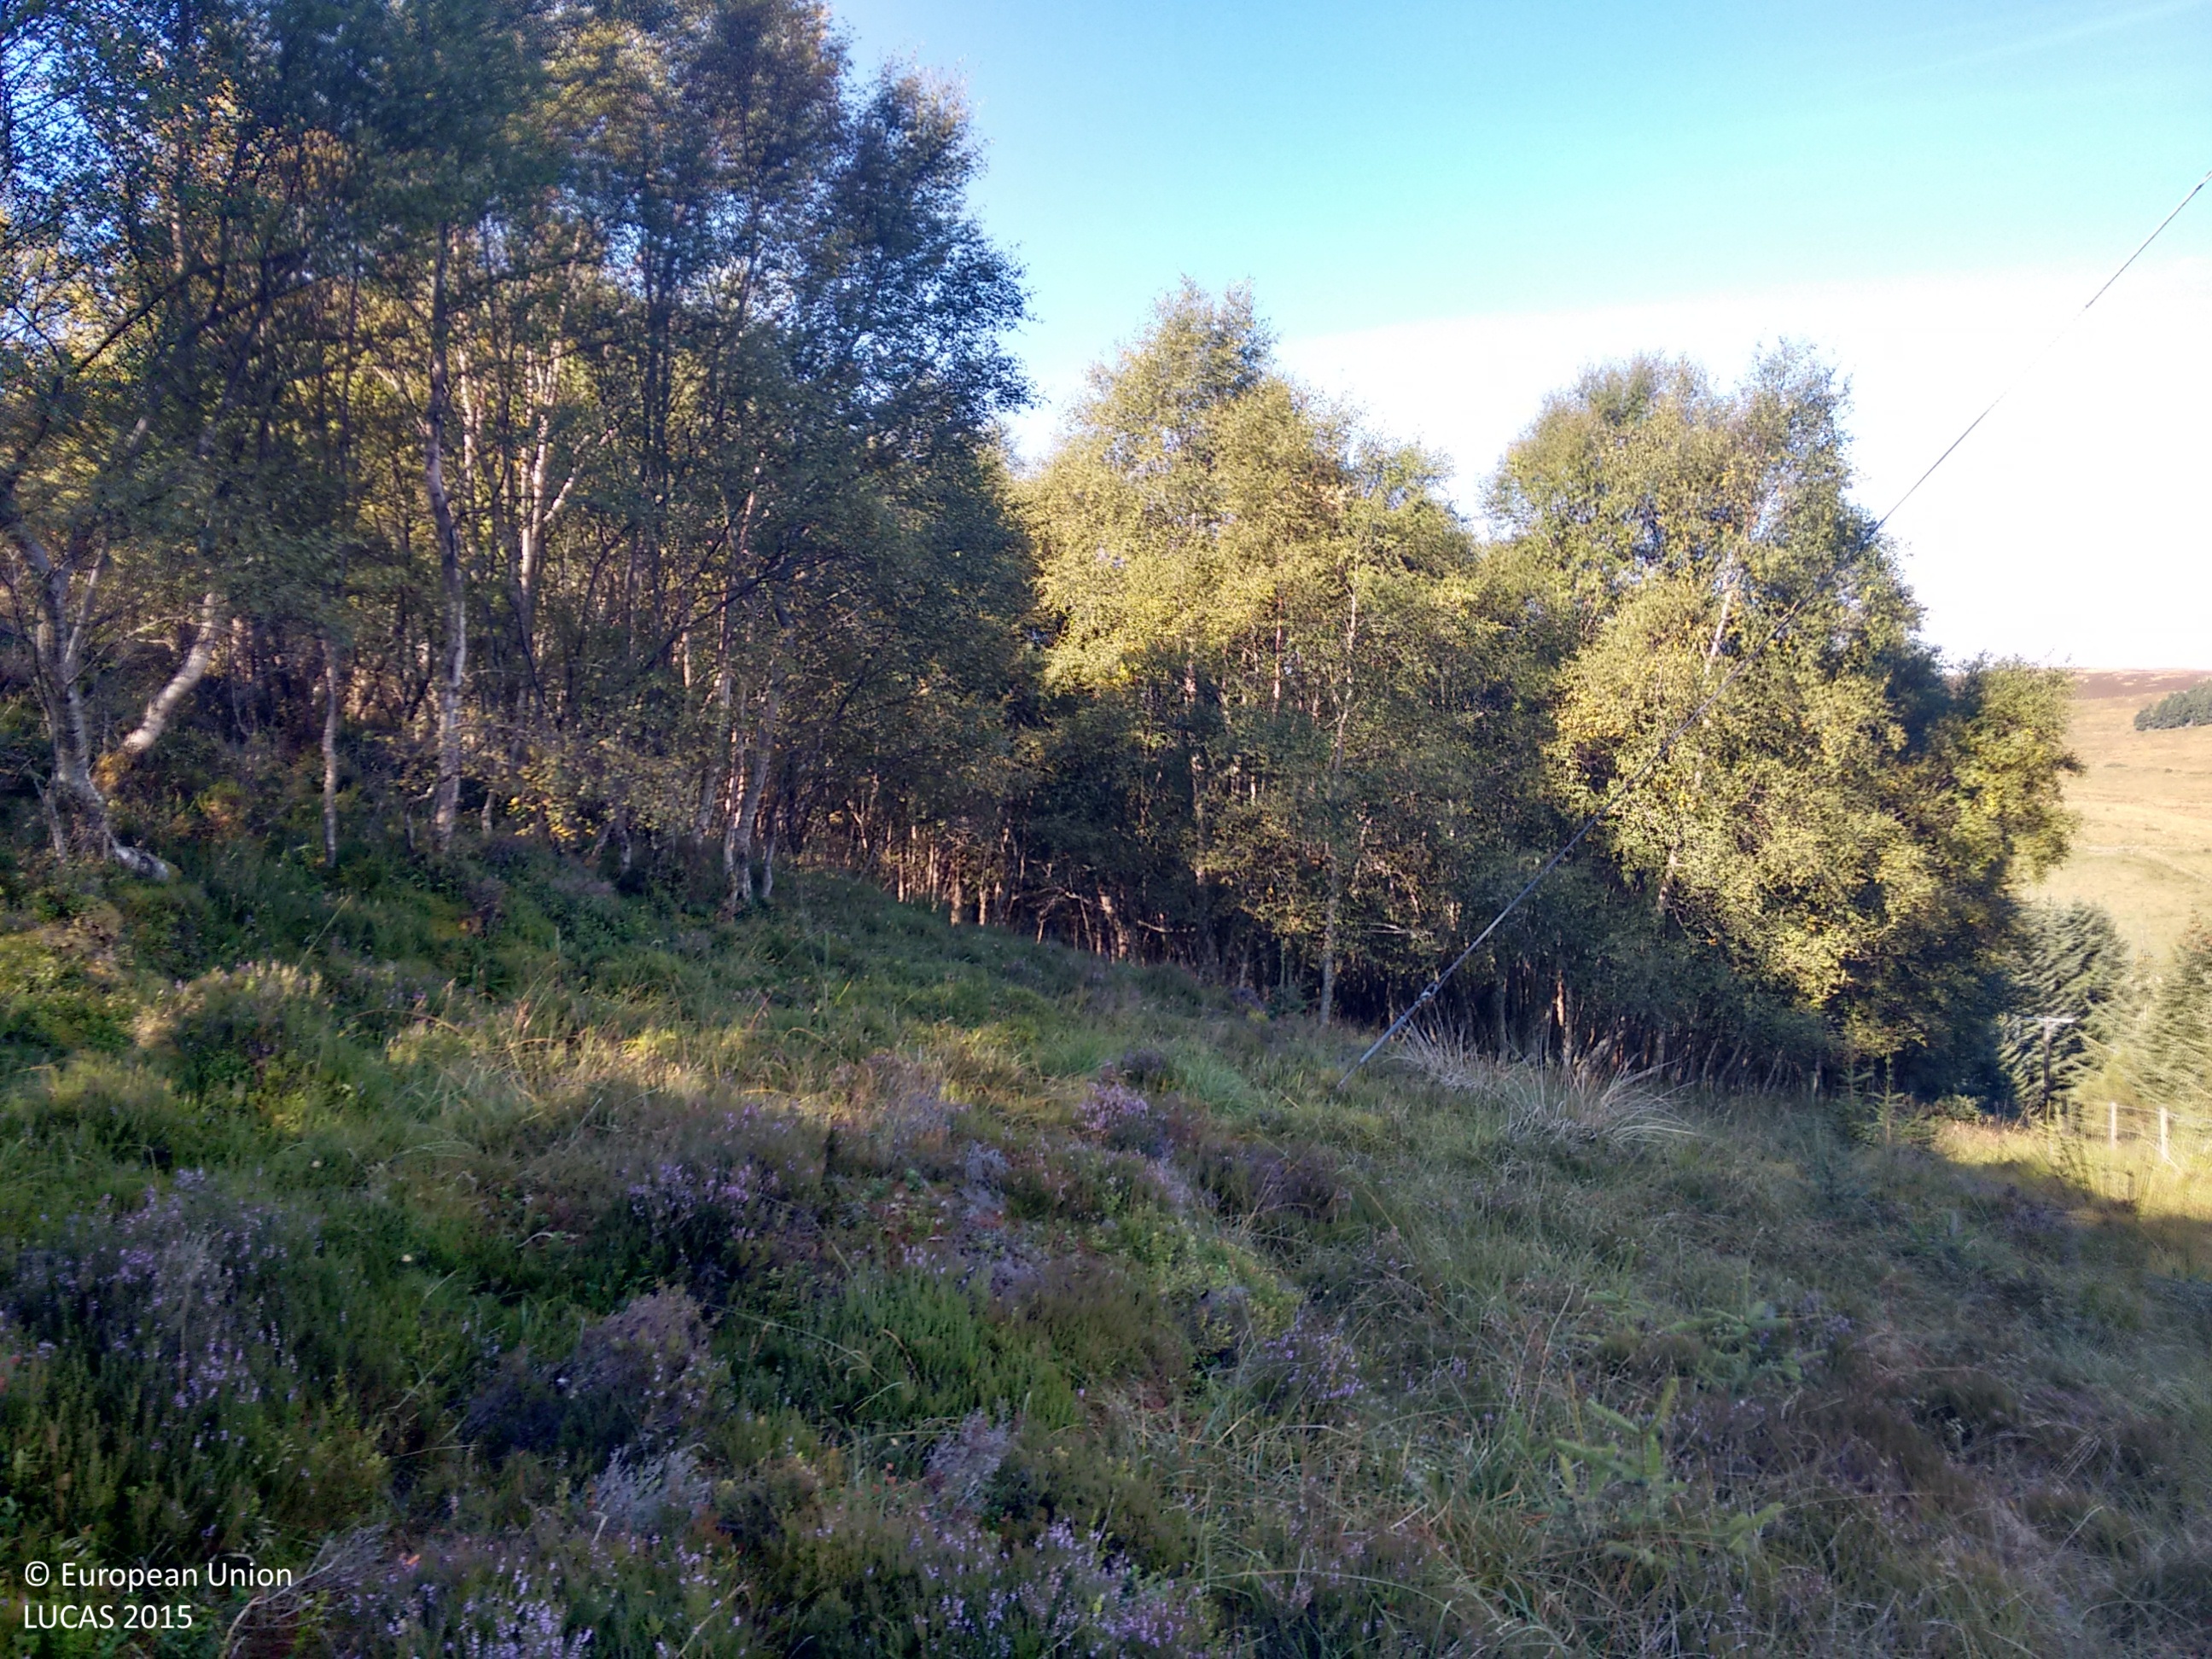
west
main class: Shrubland
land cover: Shrubland with sparse tree cover
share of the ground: > 75 %
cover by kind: shrubs 70 %, lichens and mosses 15 %, herbaceous plants 10 %, coniferous forest trees 5 %
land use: Forestry
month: September
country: GB
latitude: 57.7196
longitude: -4.3394
